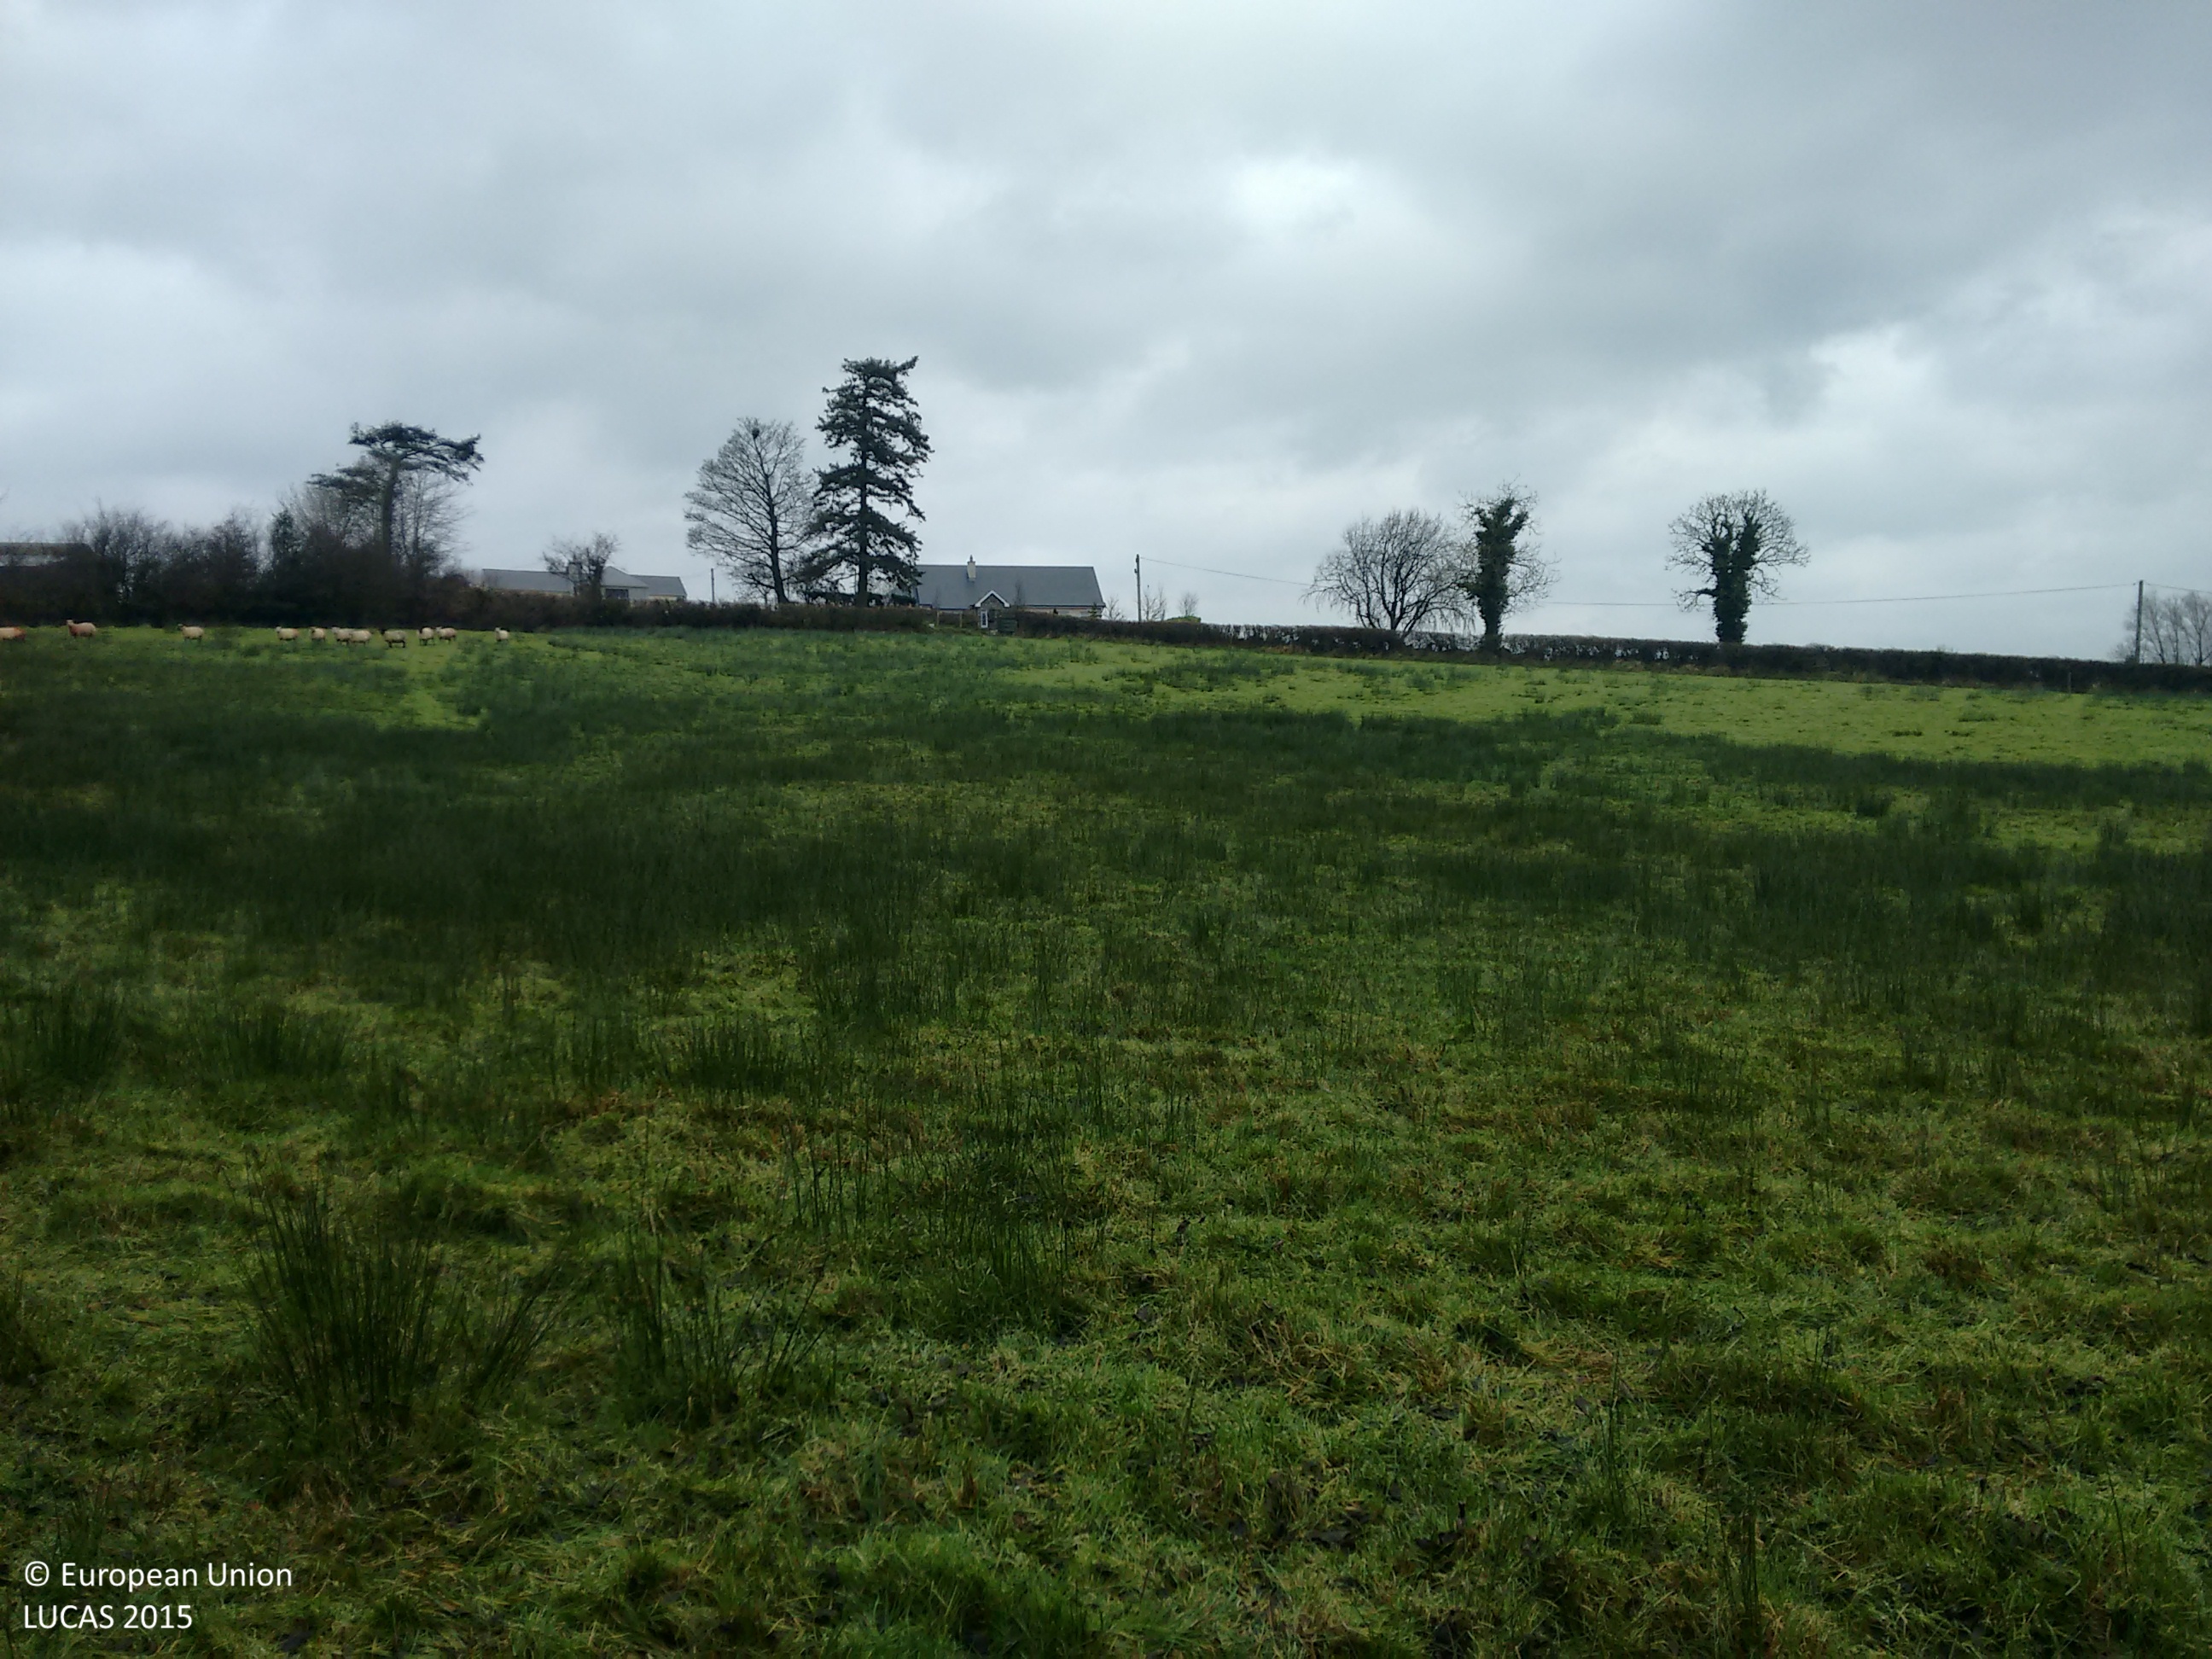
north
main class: Grassland
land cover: Grassland without tree/shrub cover
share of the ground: > 75 %
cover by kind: herbaceous plants 100 %
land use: Agriculture (excluding fallow land and kitchen gardens)
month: December
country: IE
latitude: 54.0529
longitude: -7.2096
